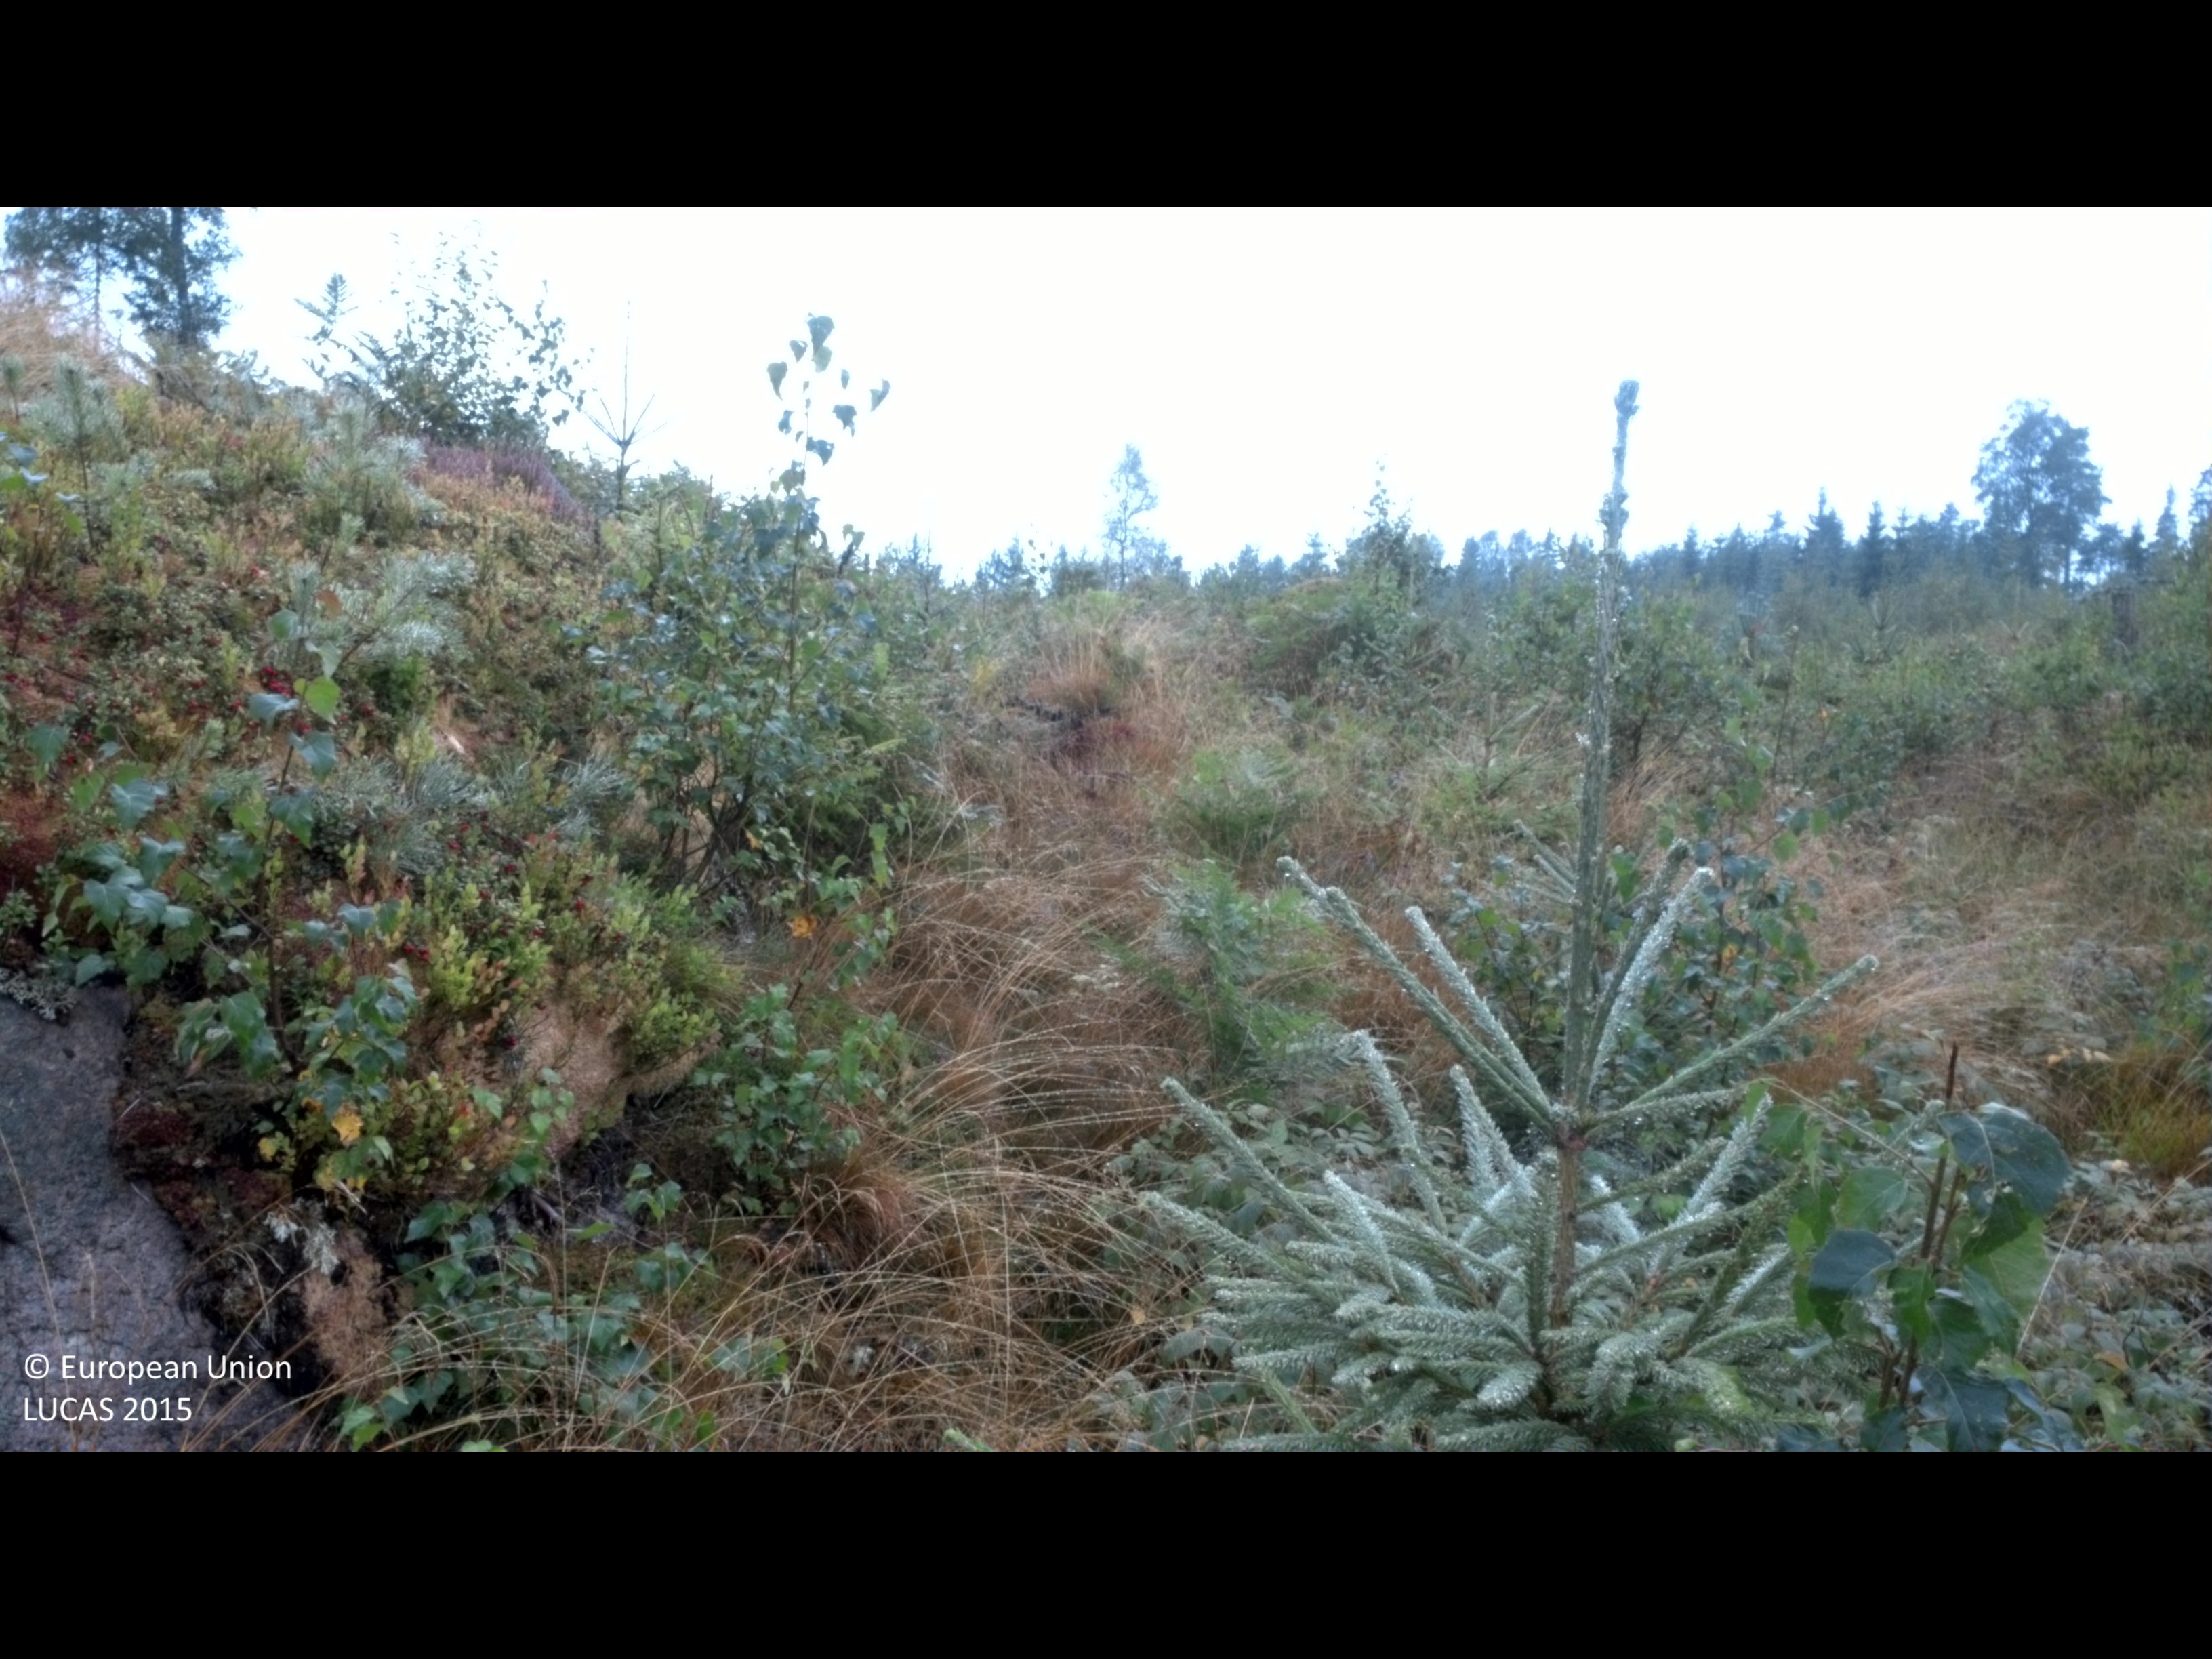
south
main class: Woodland
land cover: Spruce dominated mixed woodland
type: boreal forest
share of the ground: 10 - 25 %
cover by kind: shrubs 60 %, coniferous forest trees 15 %, broadleaved forest trees 10 %, herbaceous plants 10 %, lichens and mosses 5 %
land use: Forestry
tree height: < 5 m
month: September
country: SE
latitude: 57.3885
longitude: 13.9053
